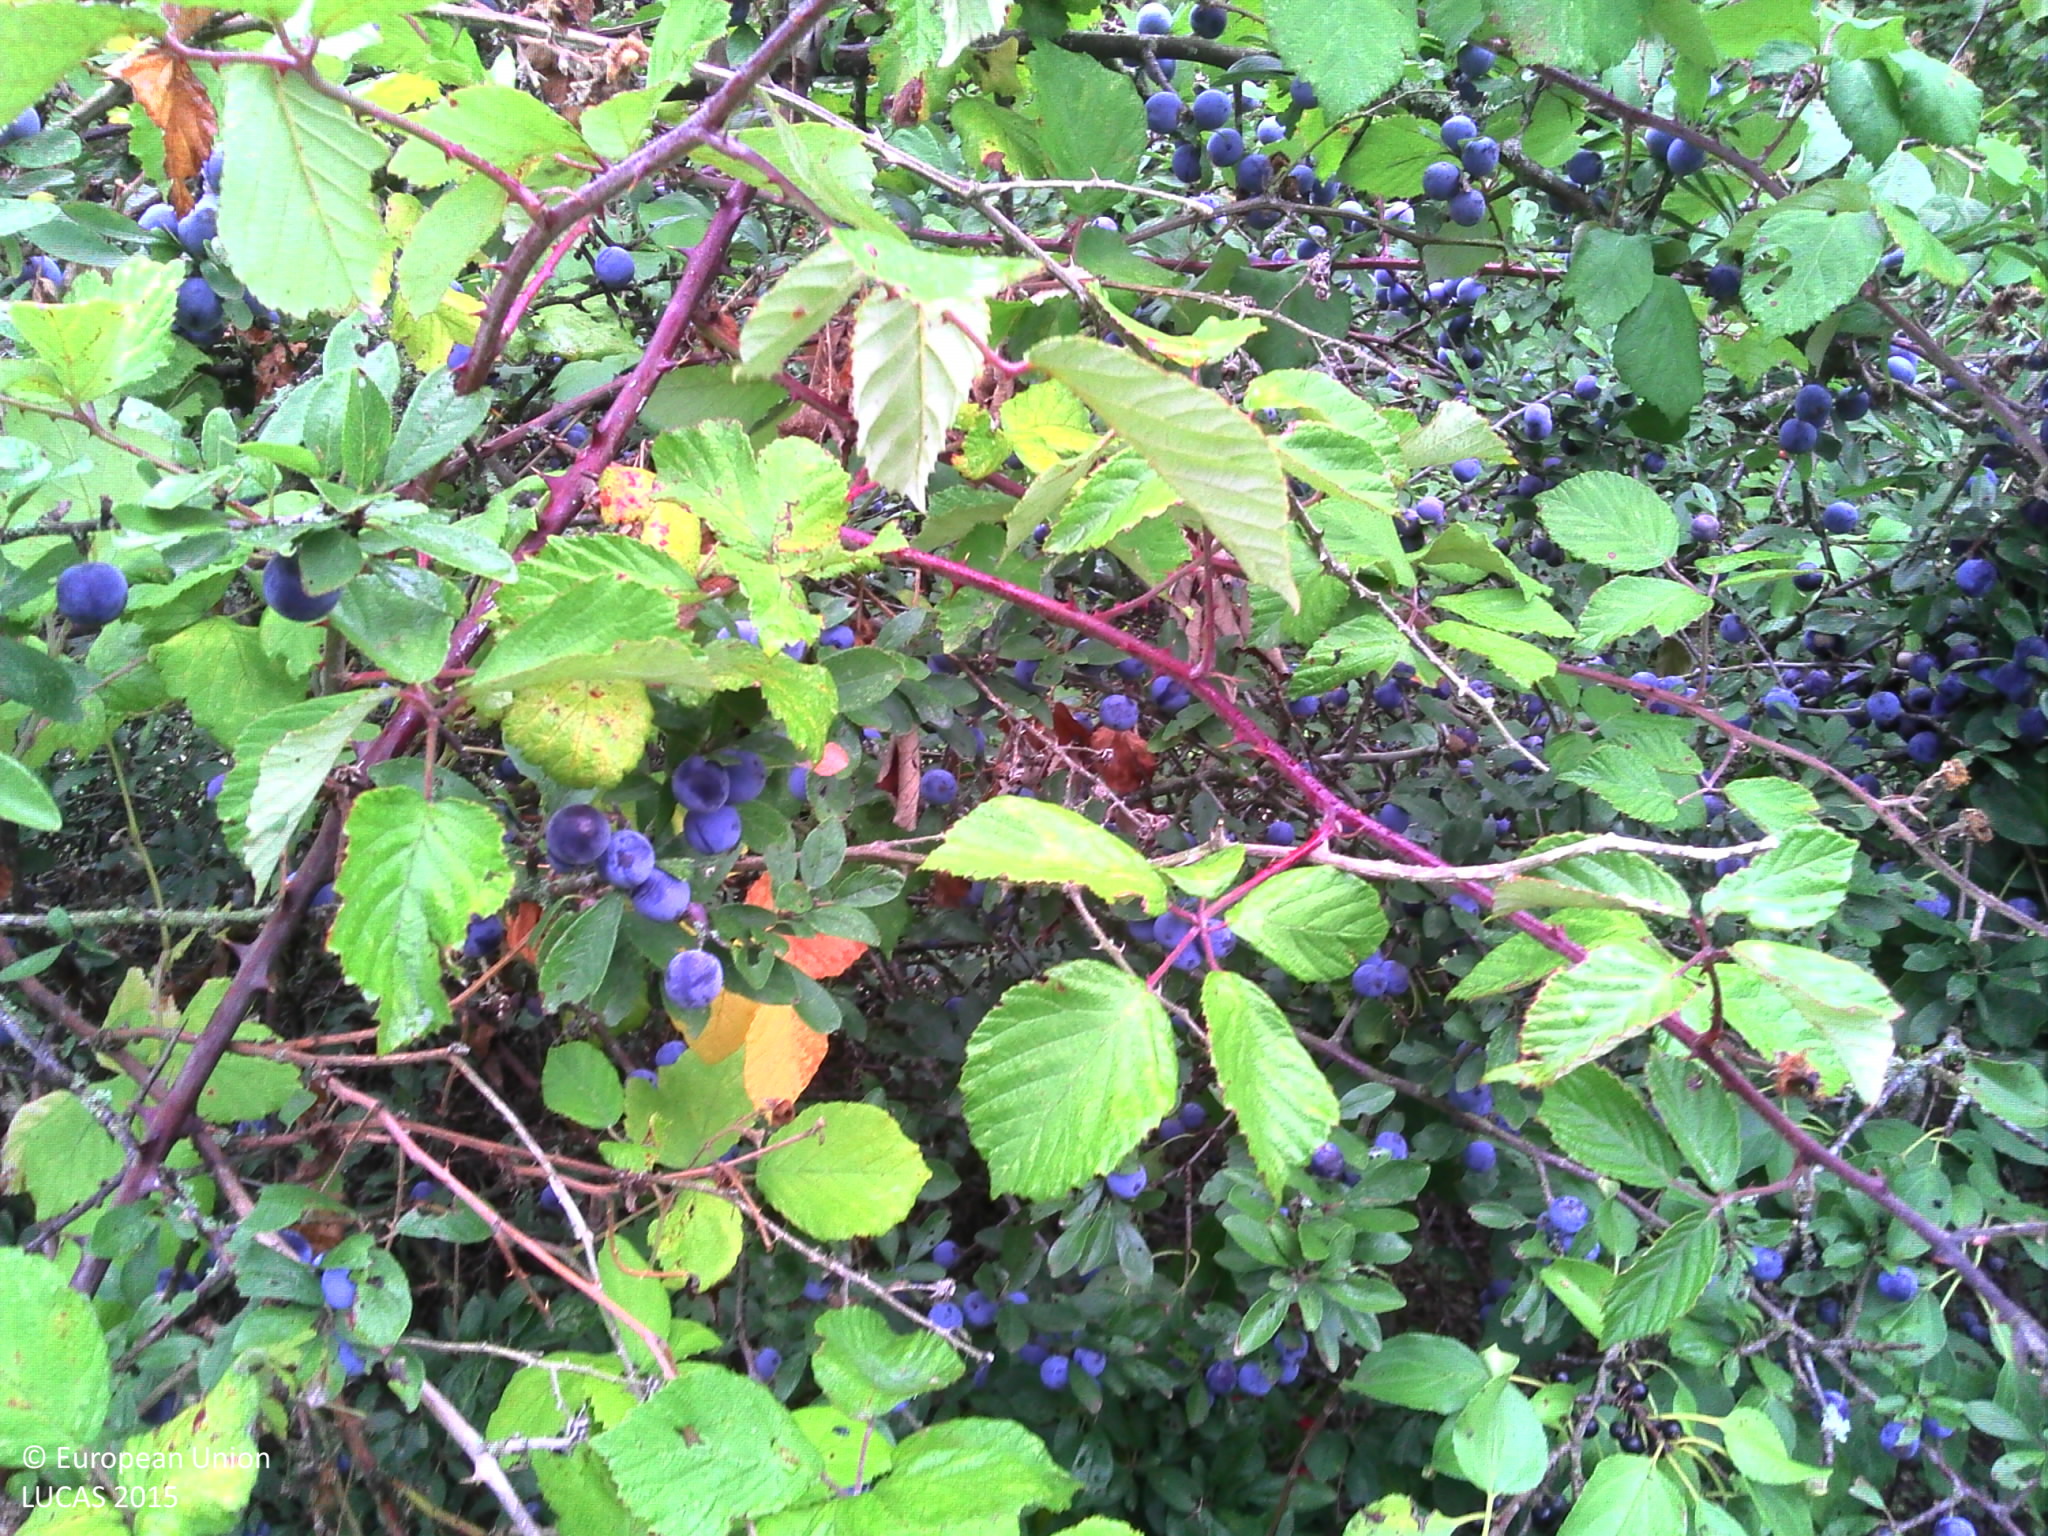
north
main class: Woodland
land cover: Broadleaved woodland
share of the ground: > 75 %
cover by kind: broadleaved forest trees 85 %, shrubs 10 %, herbaceous plants 5 %
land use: Agriculture (excluding fallow land and kitchen gardens)
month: September
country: FR
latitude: 47.6135
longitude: 4.4244
